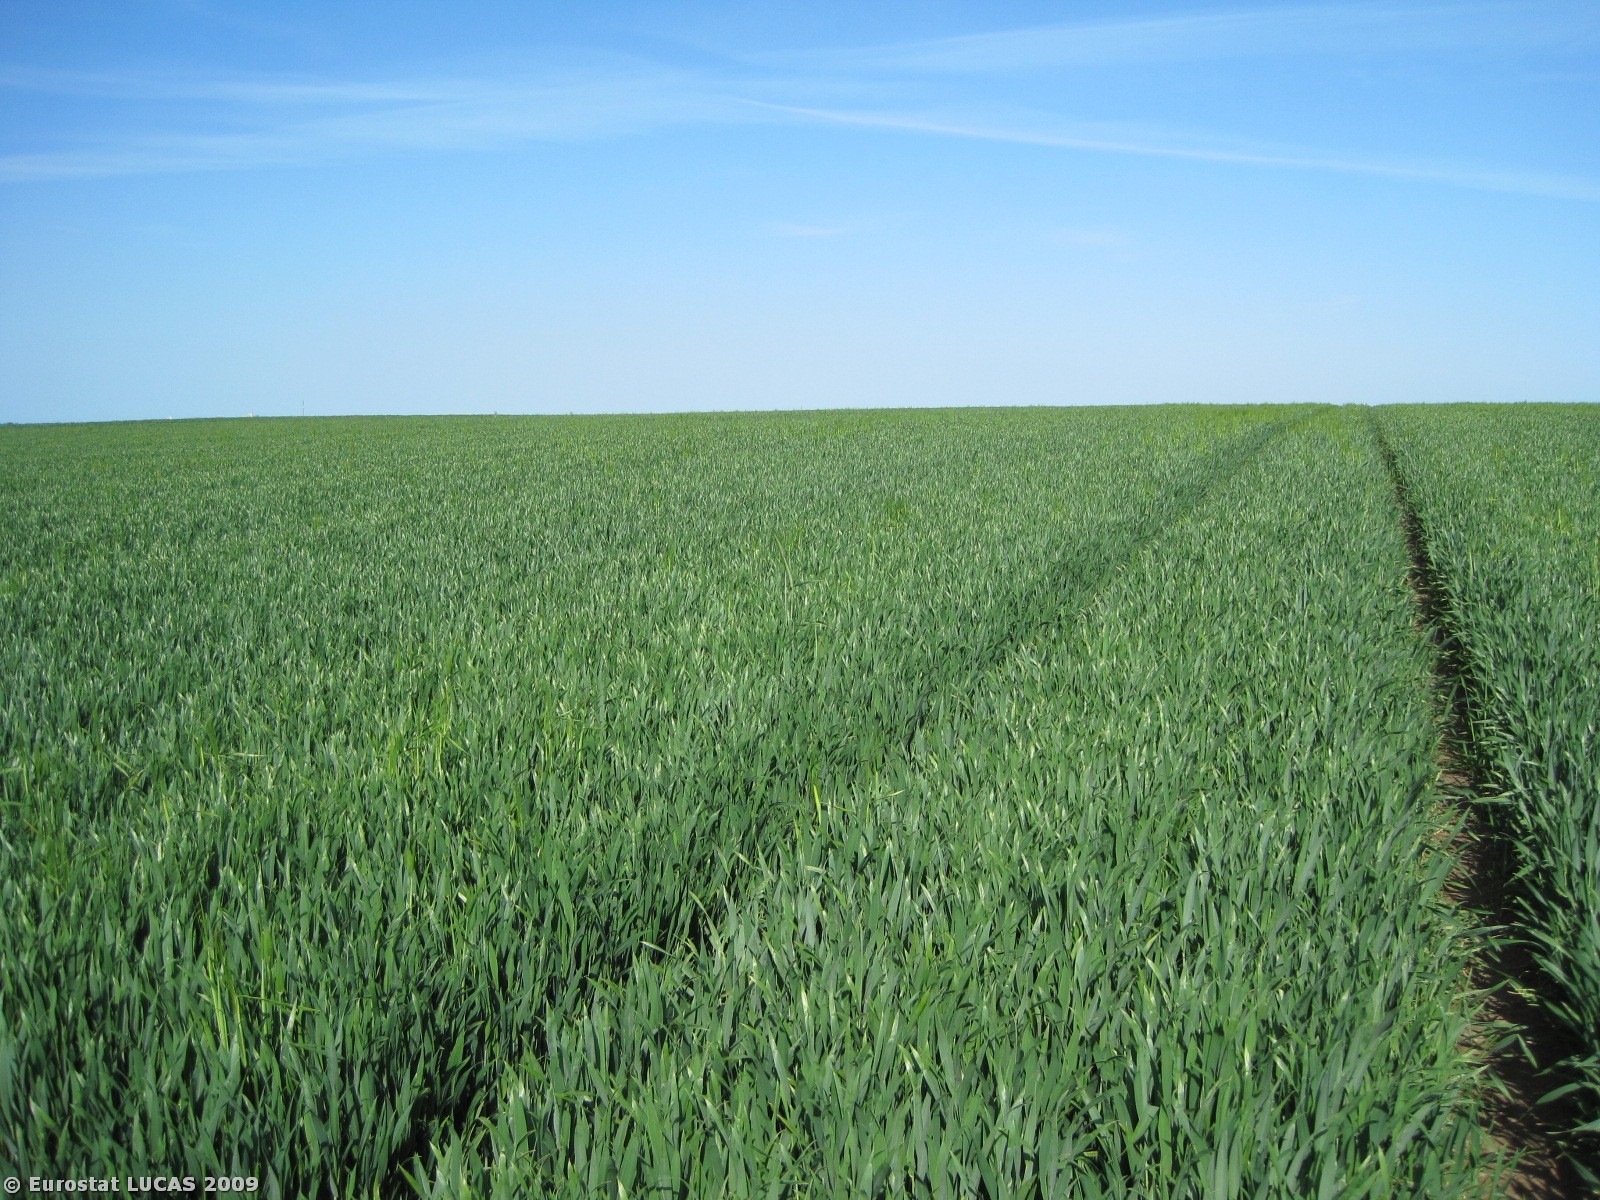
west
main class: Cropland
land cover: Common wheat
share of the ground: > 75 %
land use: Agriculture (excluding fallow land and kitchen gardens)
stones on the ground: < 10 %
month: May
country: DK
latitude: 56.4932
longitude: 10.1460
